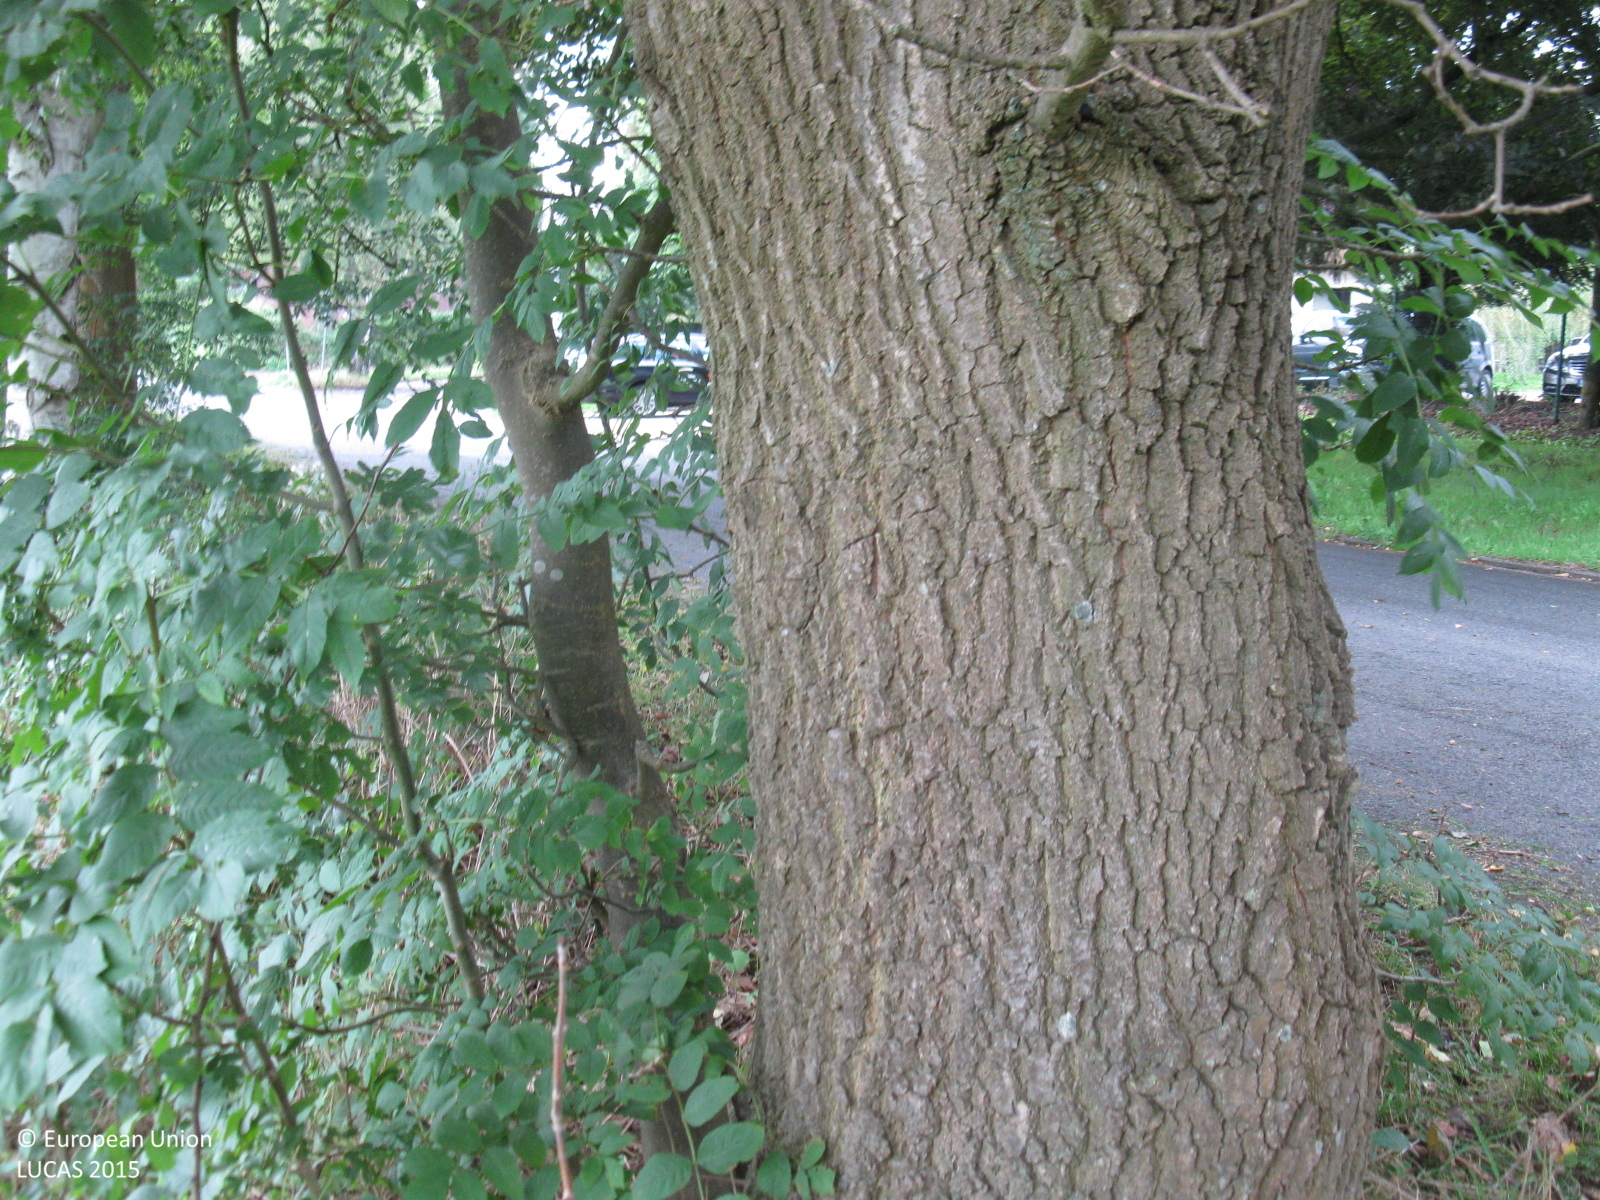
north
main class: Grassland
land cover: Grassland without tree/shrub cover
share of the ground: > 75 %
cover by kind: herbaceous plants 100 %
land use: Agriculture (excluding fallow land and kitchen gardens)
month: August
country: DE
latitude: 51.7101
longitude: 7.0043
